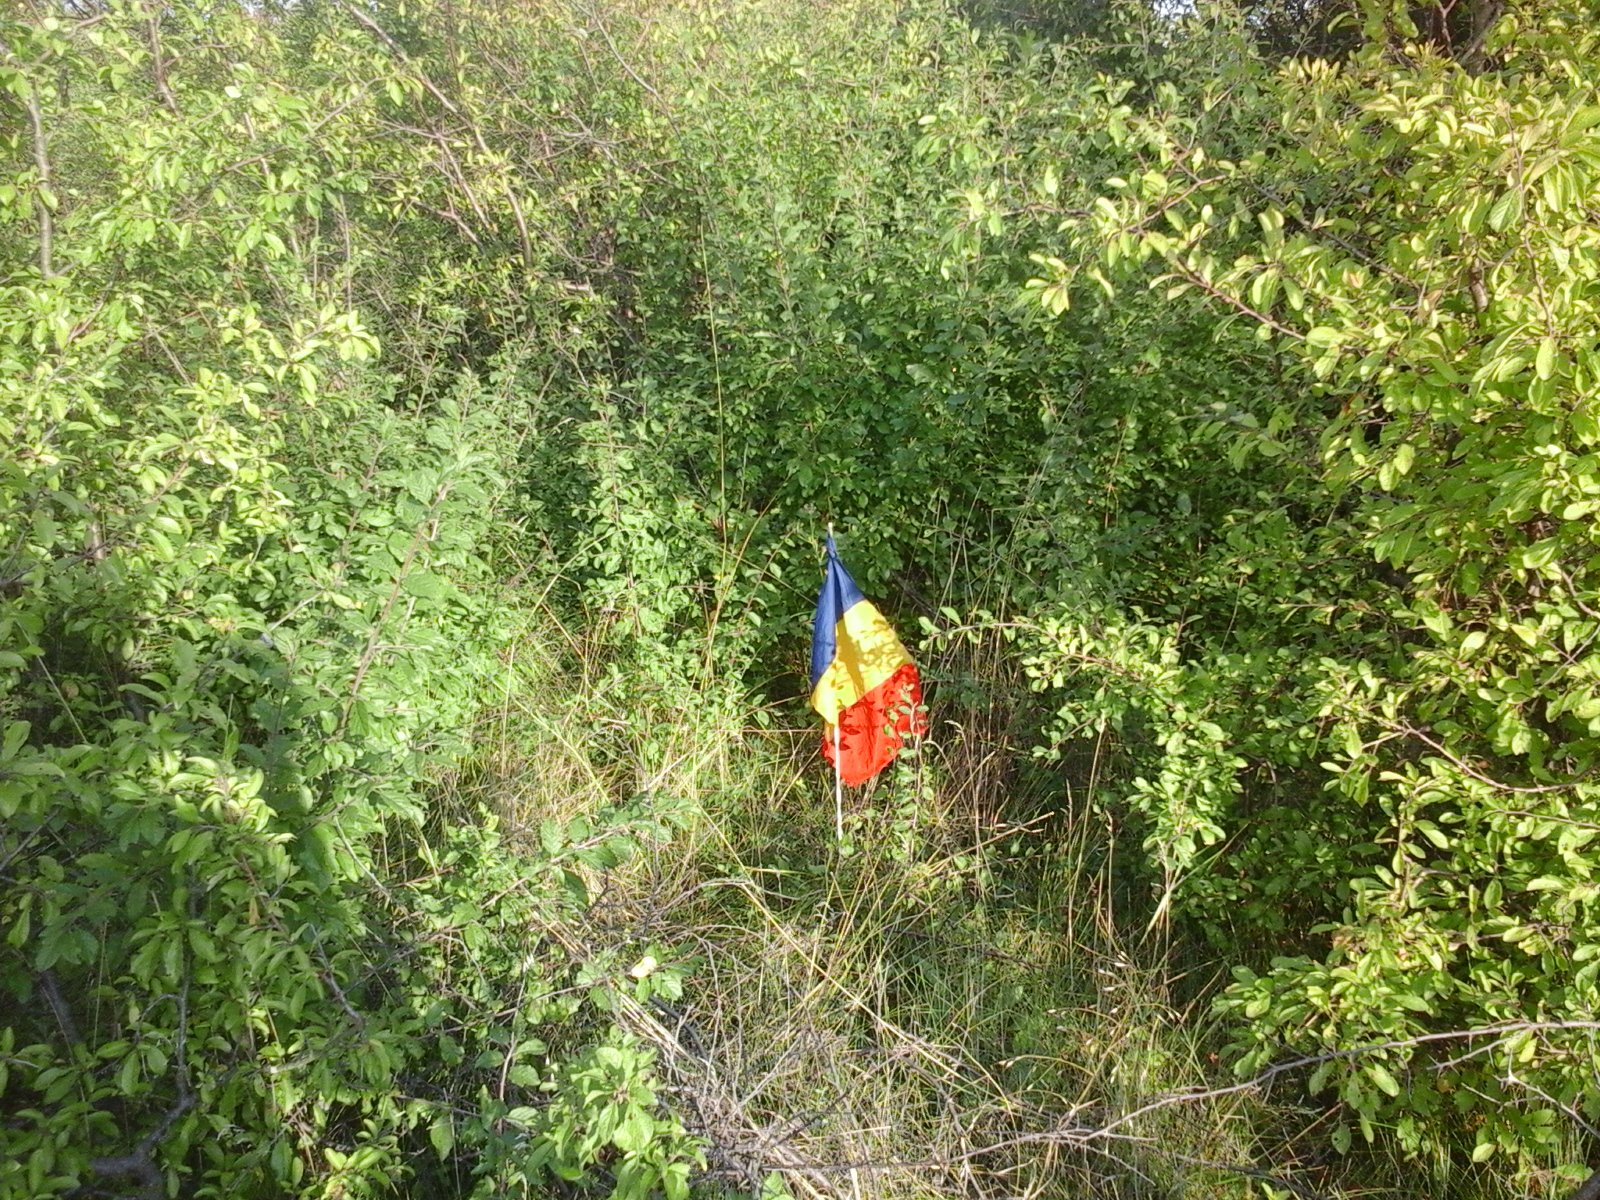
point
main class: Shrubland
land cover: Shrubland without tree cover
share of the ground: > 75 %
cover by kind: shrubs 100 %
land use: Railway transport
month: August
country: RO
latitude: 46.7011
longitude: 21.5883
